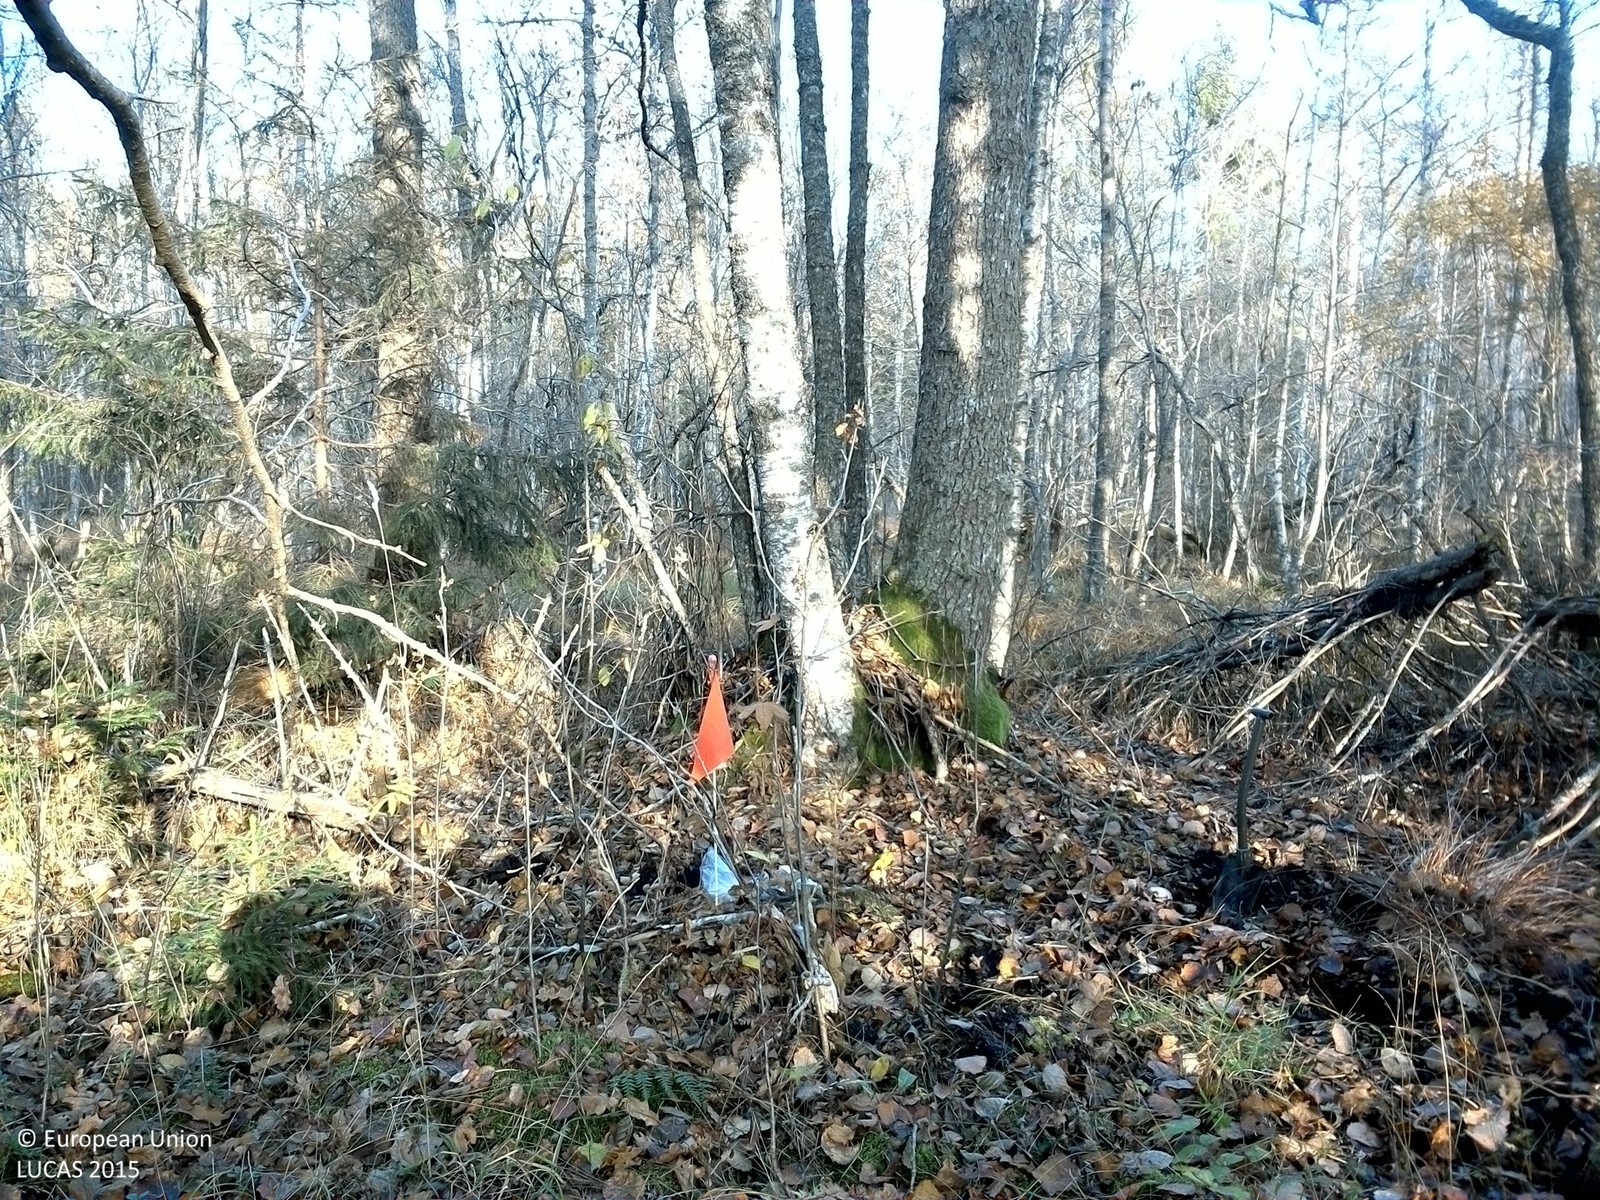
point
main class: Woodland
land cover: Broadleaved woodland
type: hemiboreal forest and nemoral coniferous forest and mixed broadleaved-coniferous forest
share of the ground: > 75 %
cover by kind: broadleaved forest trees 75 %, herbaceous plants 10 %, lichens and mosses 10 %, coniferous forest trees 5 %
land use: Forestry
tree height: > 5 m
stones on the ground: < 10 %
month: October
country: SE
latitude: 59.4091
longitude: 17.0234
